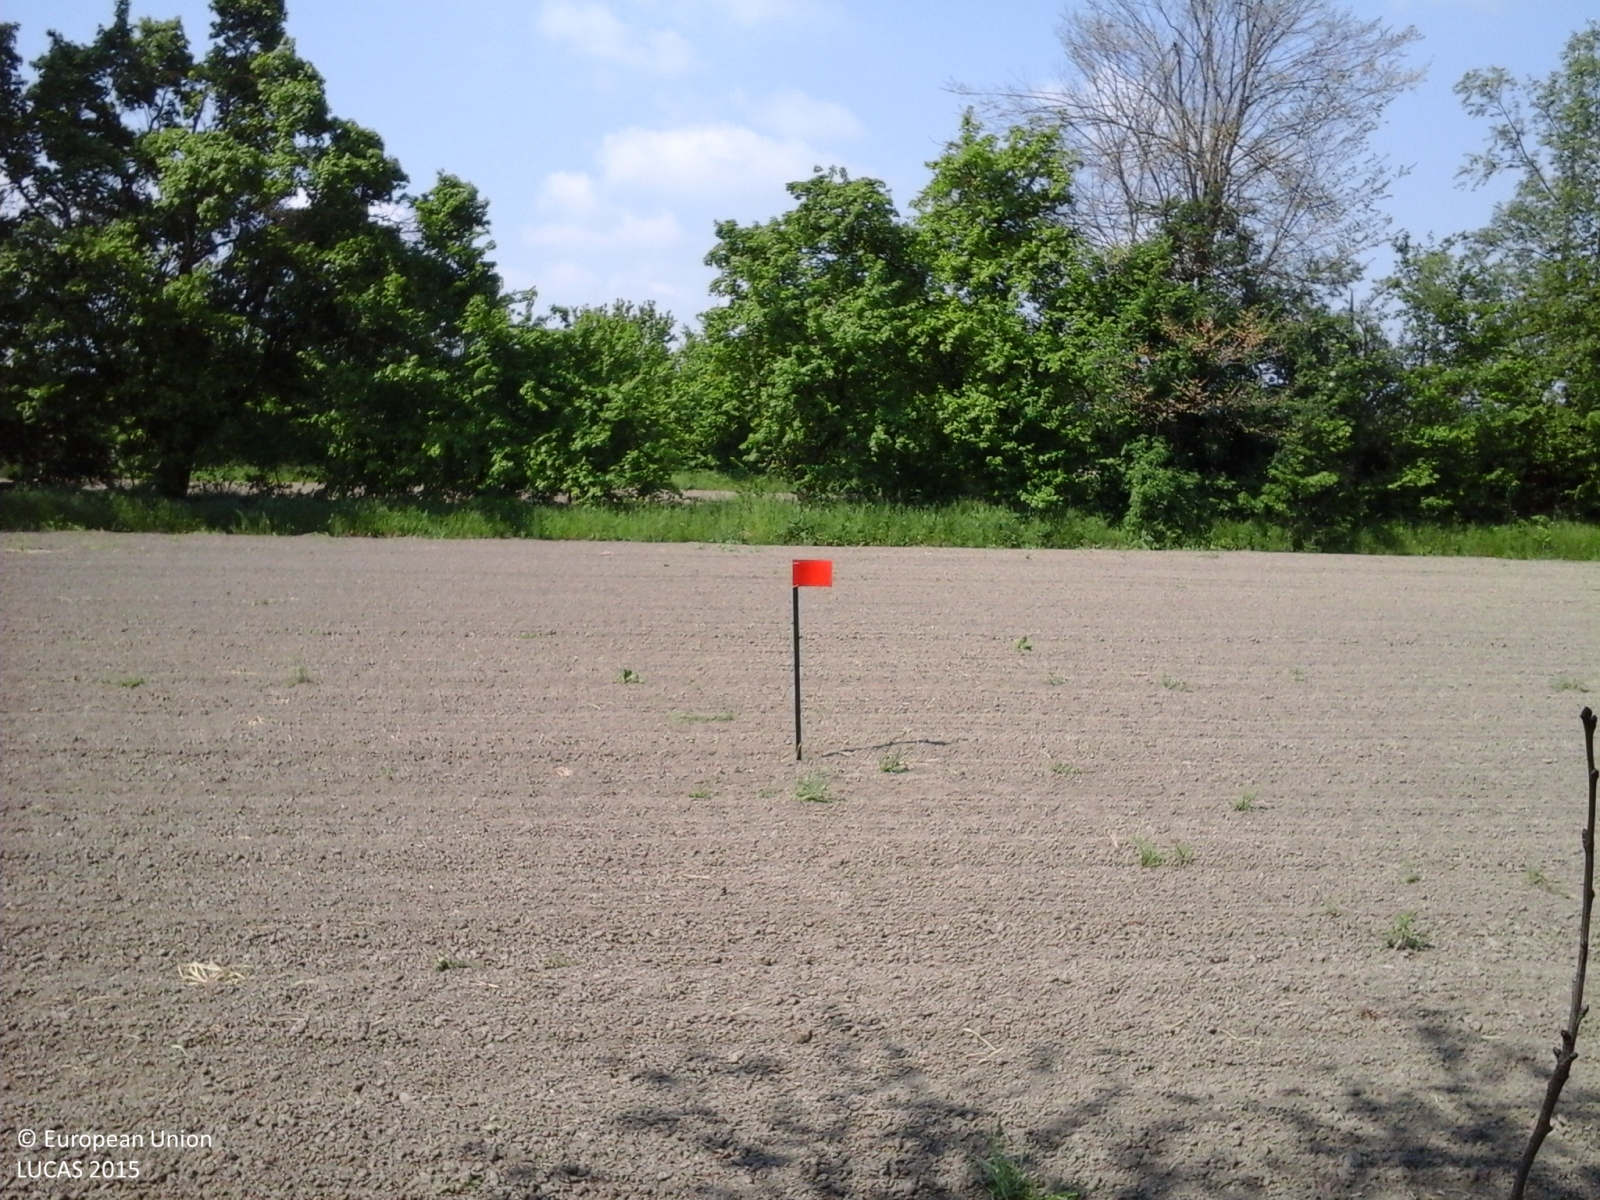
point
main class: Cropland
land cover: Soya
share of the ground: > 75 %
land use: Agriculture (excluding fallow land and kitchen gardens)
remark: Tilled/Sowed
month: April
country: IT
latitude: 44.9240
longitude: 10.8724
